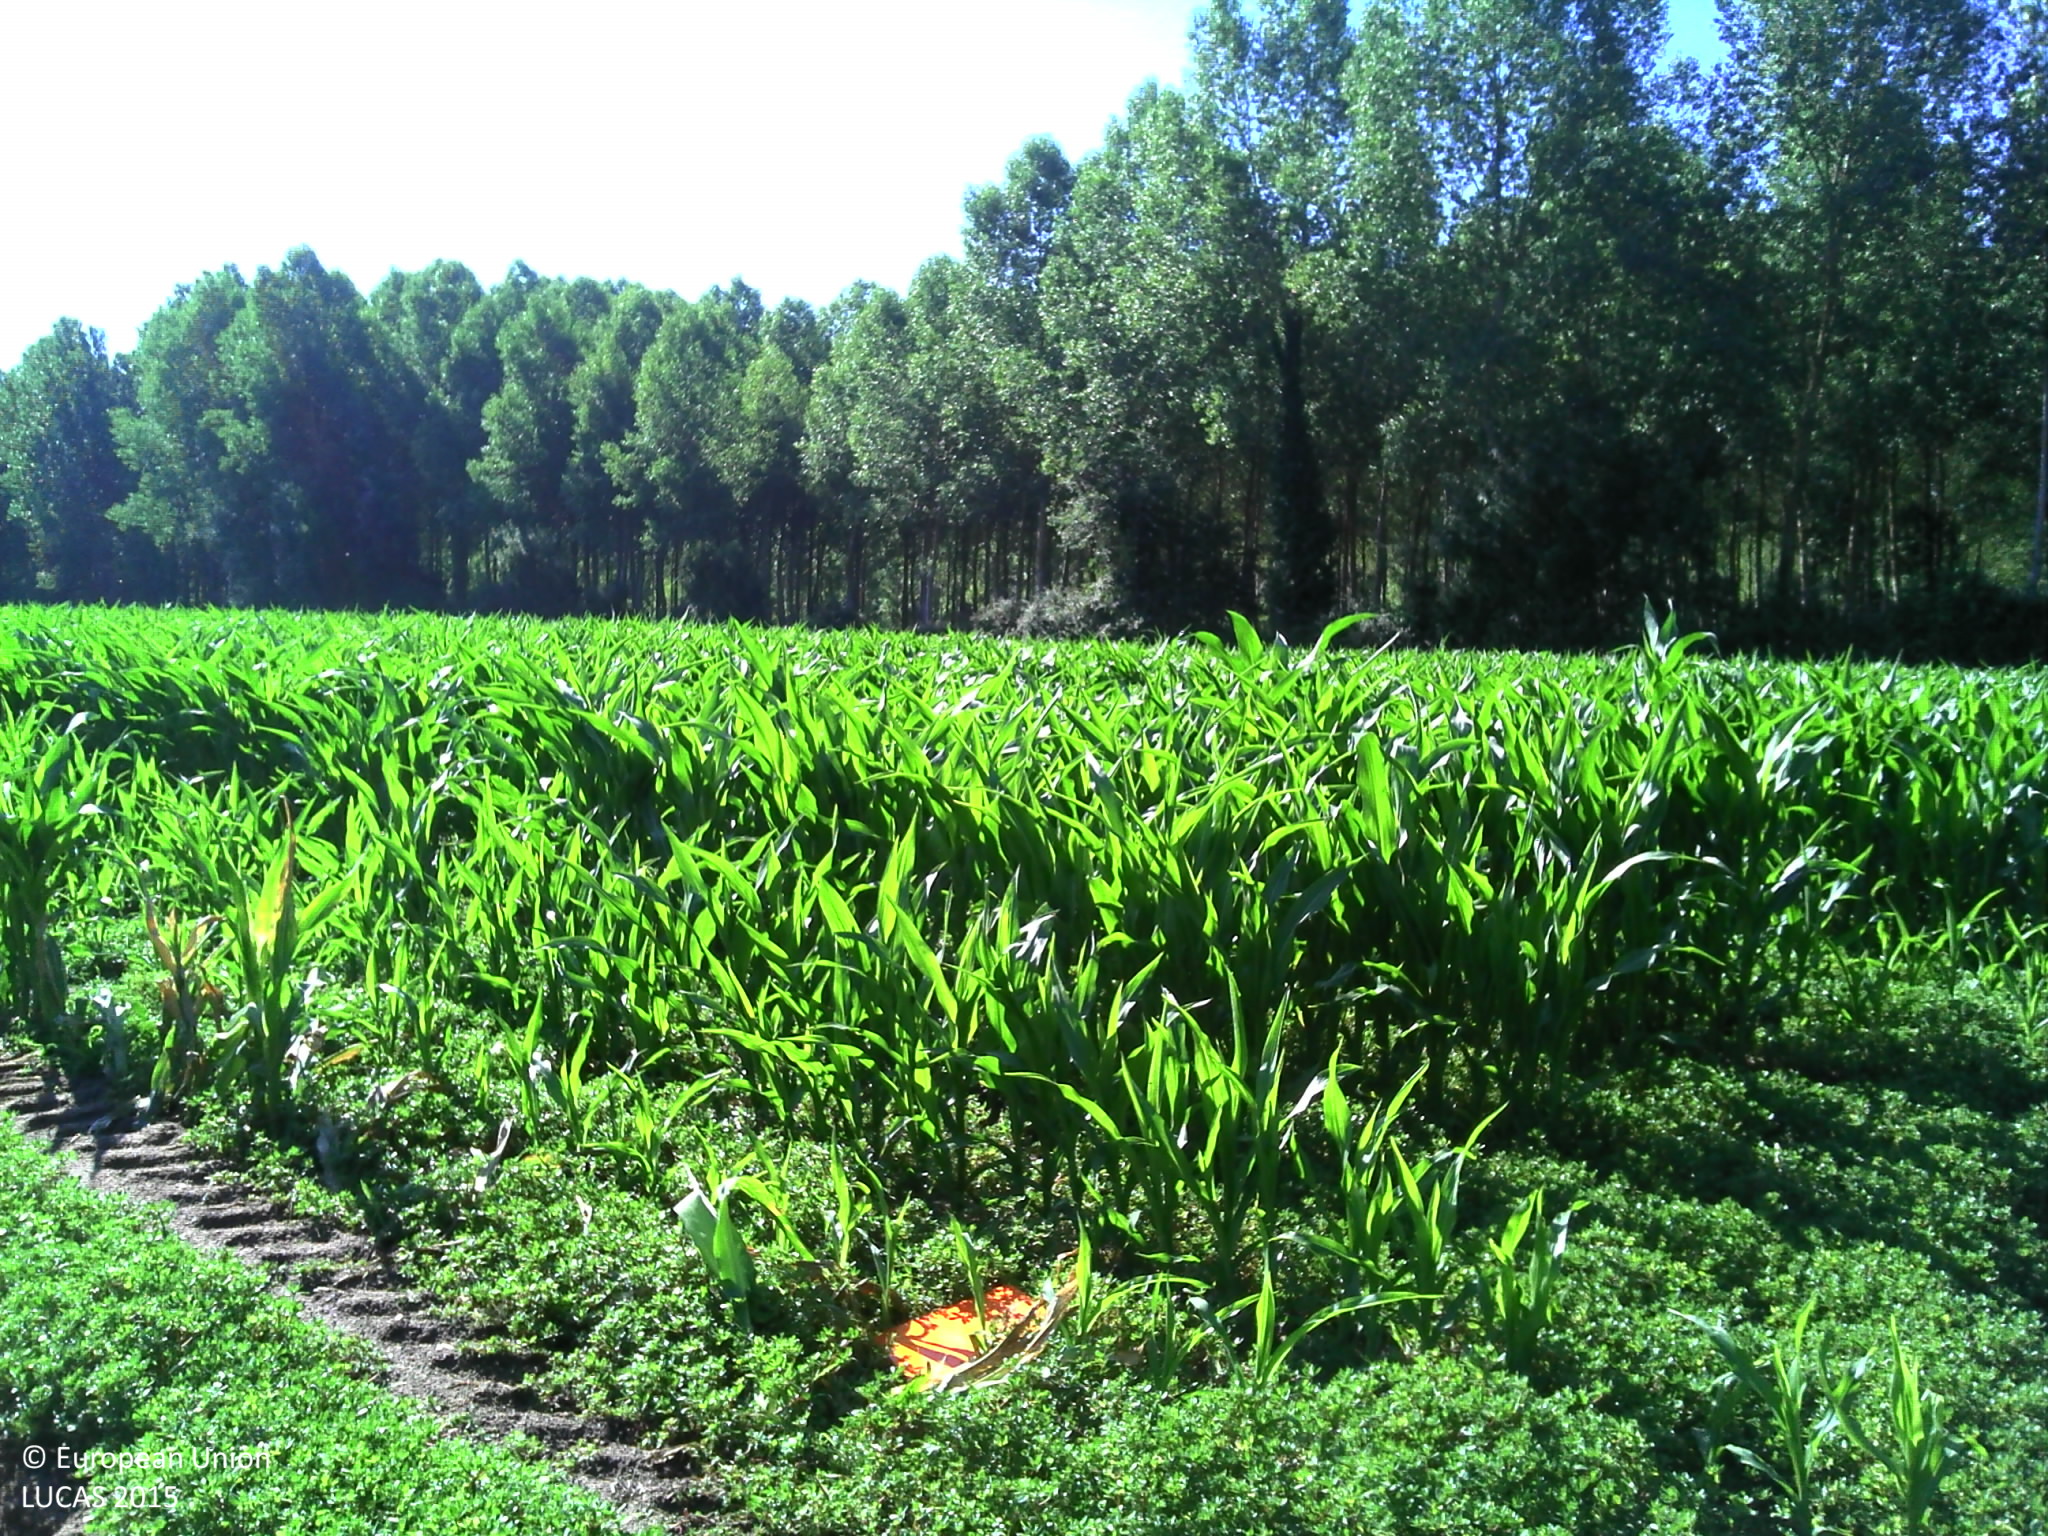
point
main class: Cropland
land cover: Maize
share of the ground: > 75 %
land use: Agriculture (excluding fallow land and kitchen gardens)
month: July
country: FR
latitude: 47.6628
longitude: 0.2414
